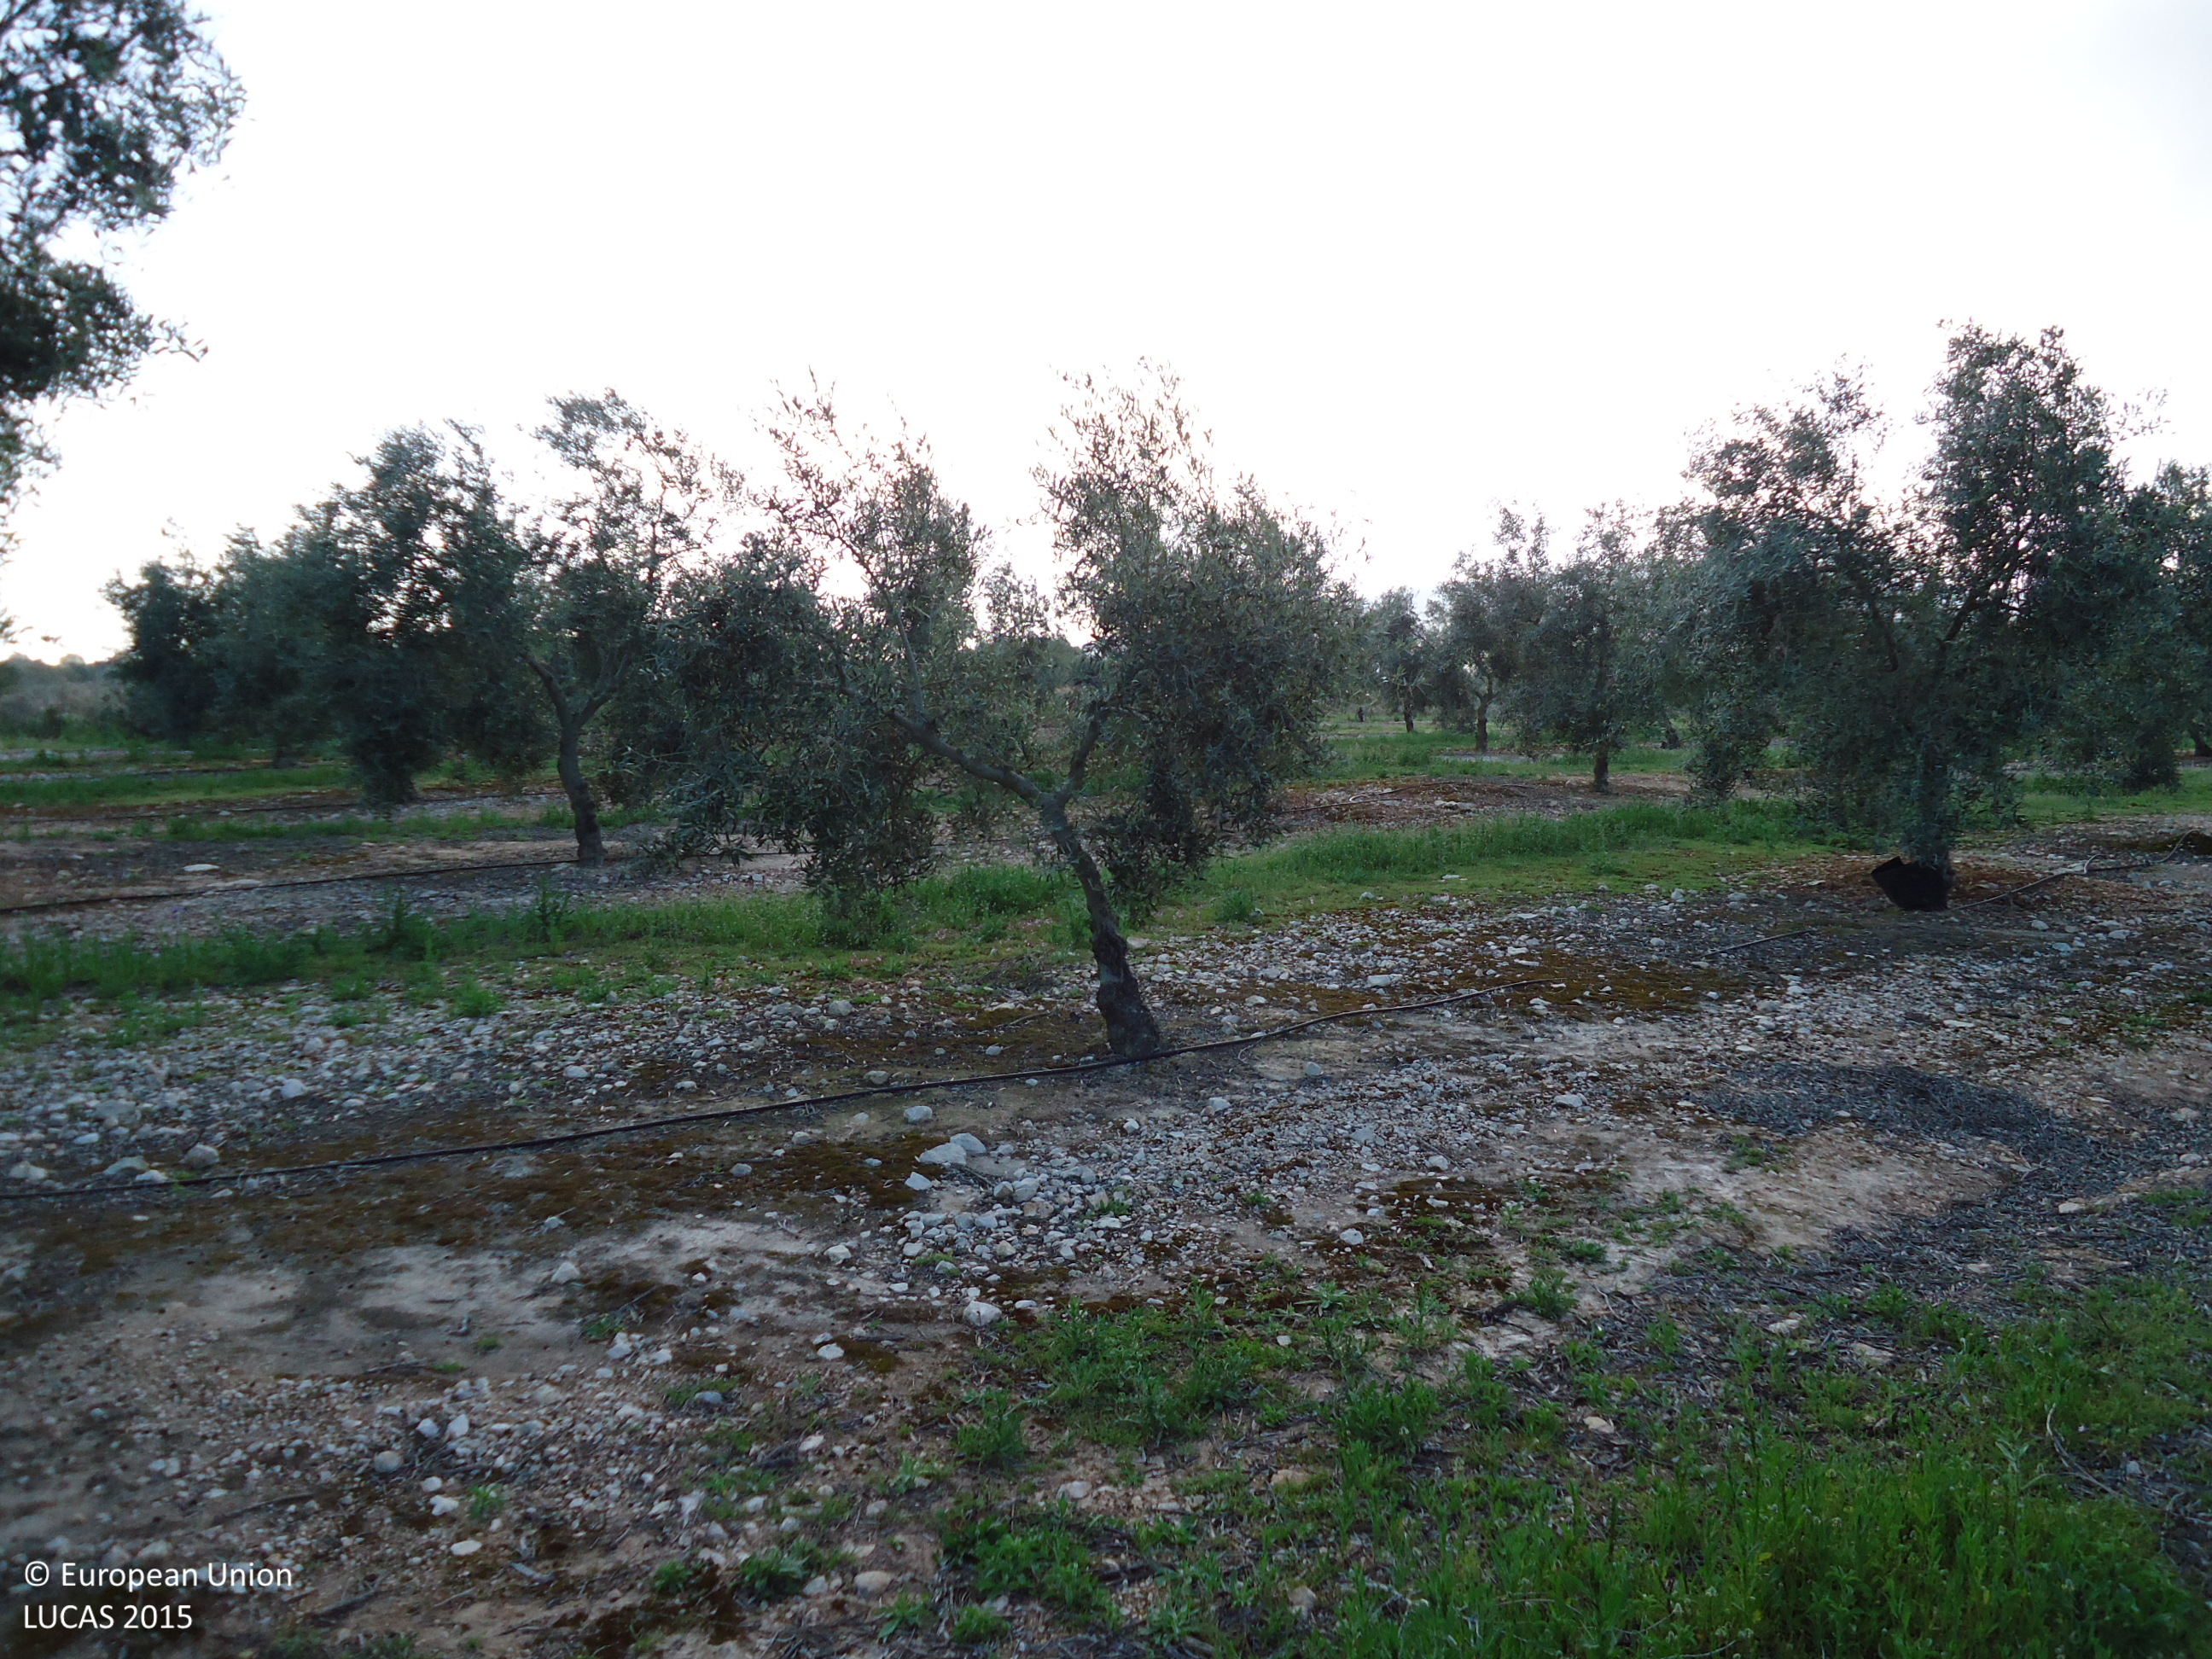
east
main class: Cropland
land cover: Olive groves
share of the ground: 25 - 50 %
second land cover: Spontaneously vegetated surfaces
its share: 50 - 75 %
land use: Agriculture (excluding fallow land and kitchen gardens)
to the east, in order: Olive groves; Spontaneously vegetated surfaces; Other bare soil; Olive groves; Shrubland with sparse tree cover; Rock outcrops; Olive groves
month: April
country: ES
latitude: 37.1802
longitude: -4.8600
